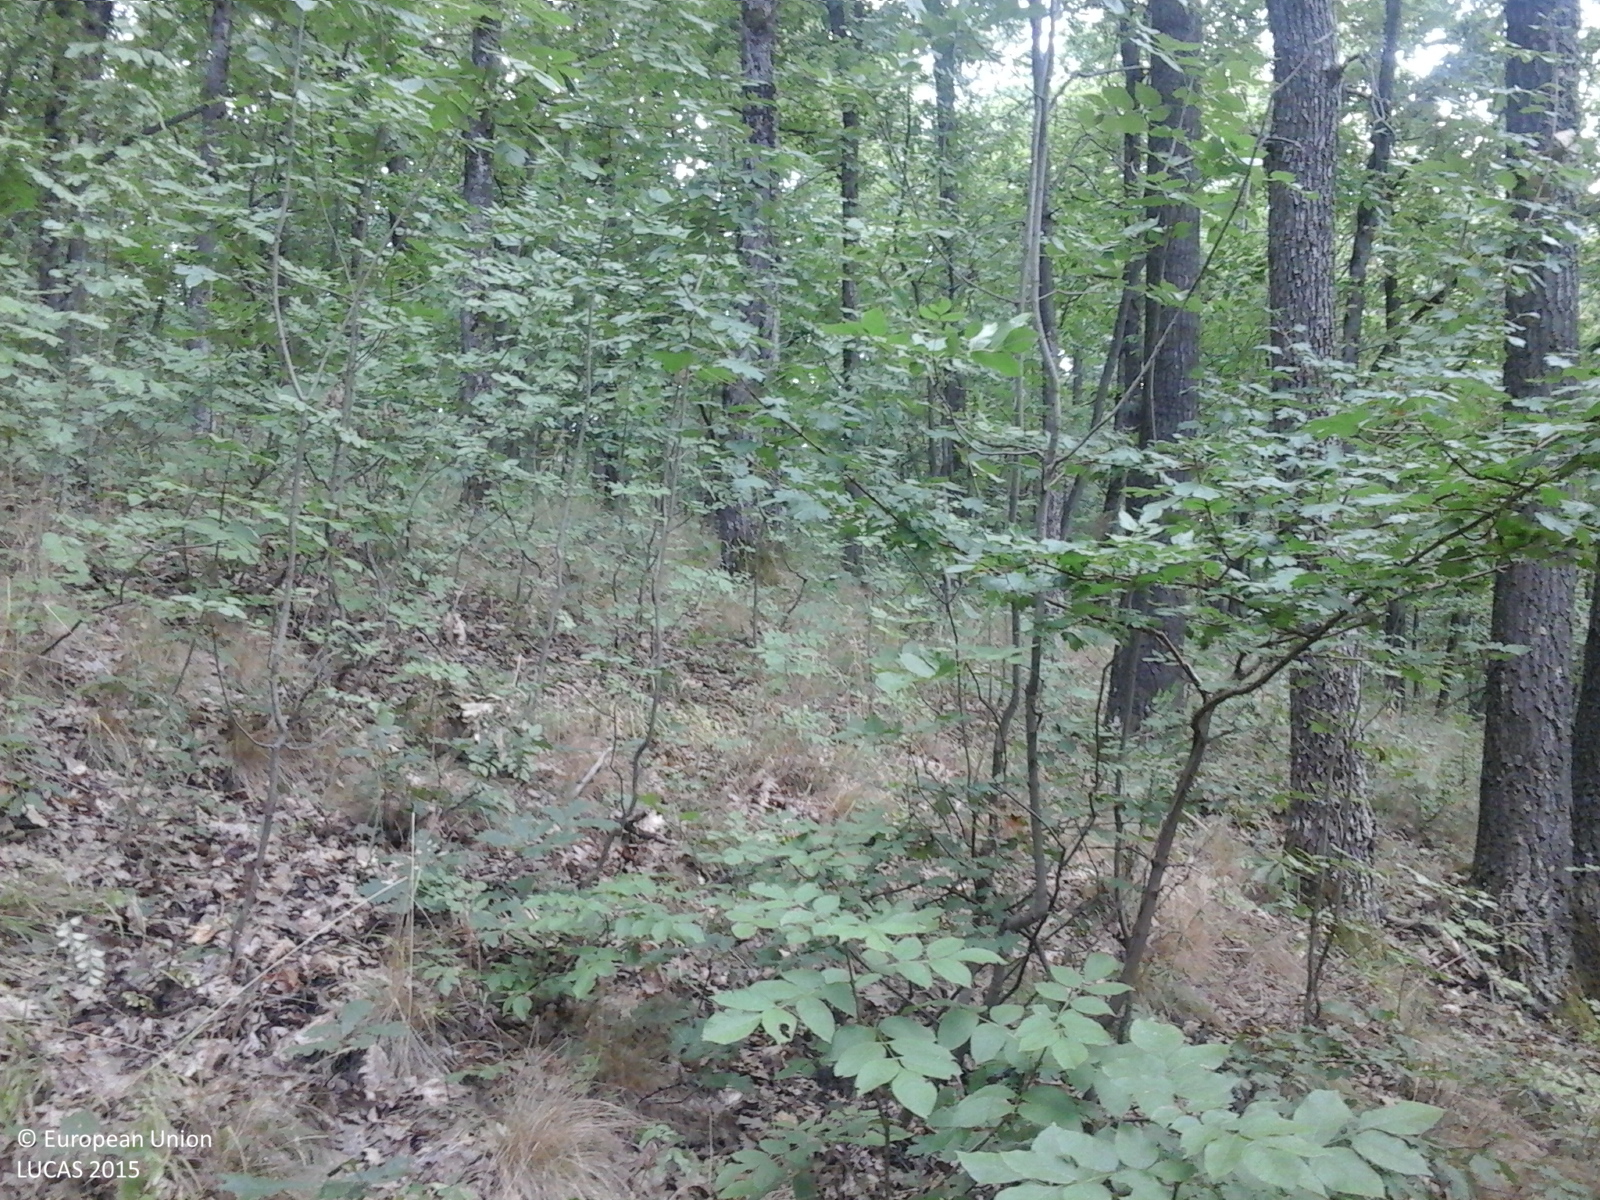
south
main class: Woodland
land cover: Broadleaved woodland
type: acidophilous oak and oak-birch forest
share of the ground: > 75 %
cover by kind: broadleaved forest trees 100 %
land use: Forestry
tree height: > 5 m
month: August
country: RO
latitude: 44.5434
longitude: 23.2016
